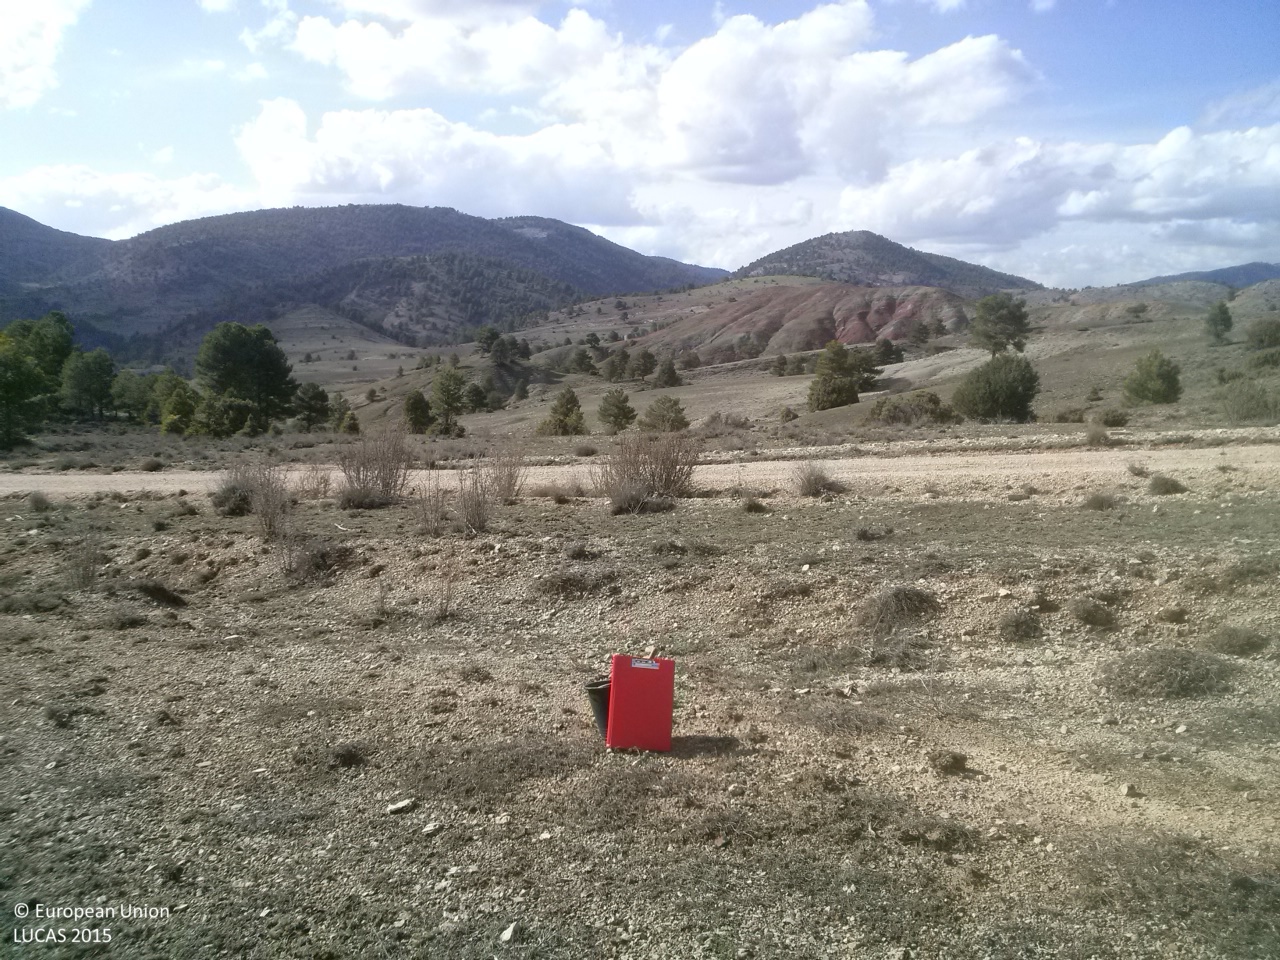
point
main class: Grassland
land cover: Grassland without tree/shrub cover
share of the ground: 50 - 75 %
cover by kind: herbaceous plants 55 %, unconsolidated bare surface 40 %, shrubs 5 %
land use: Agriculture (excluding fallow land and kitchen gardens)
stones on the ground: < 10 %
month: April
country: ES
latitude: 40.2158
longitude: -1.7527
